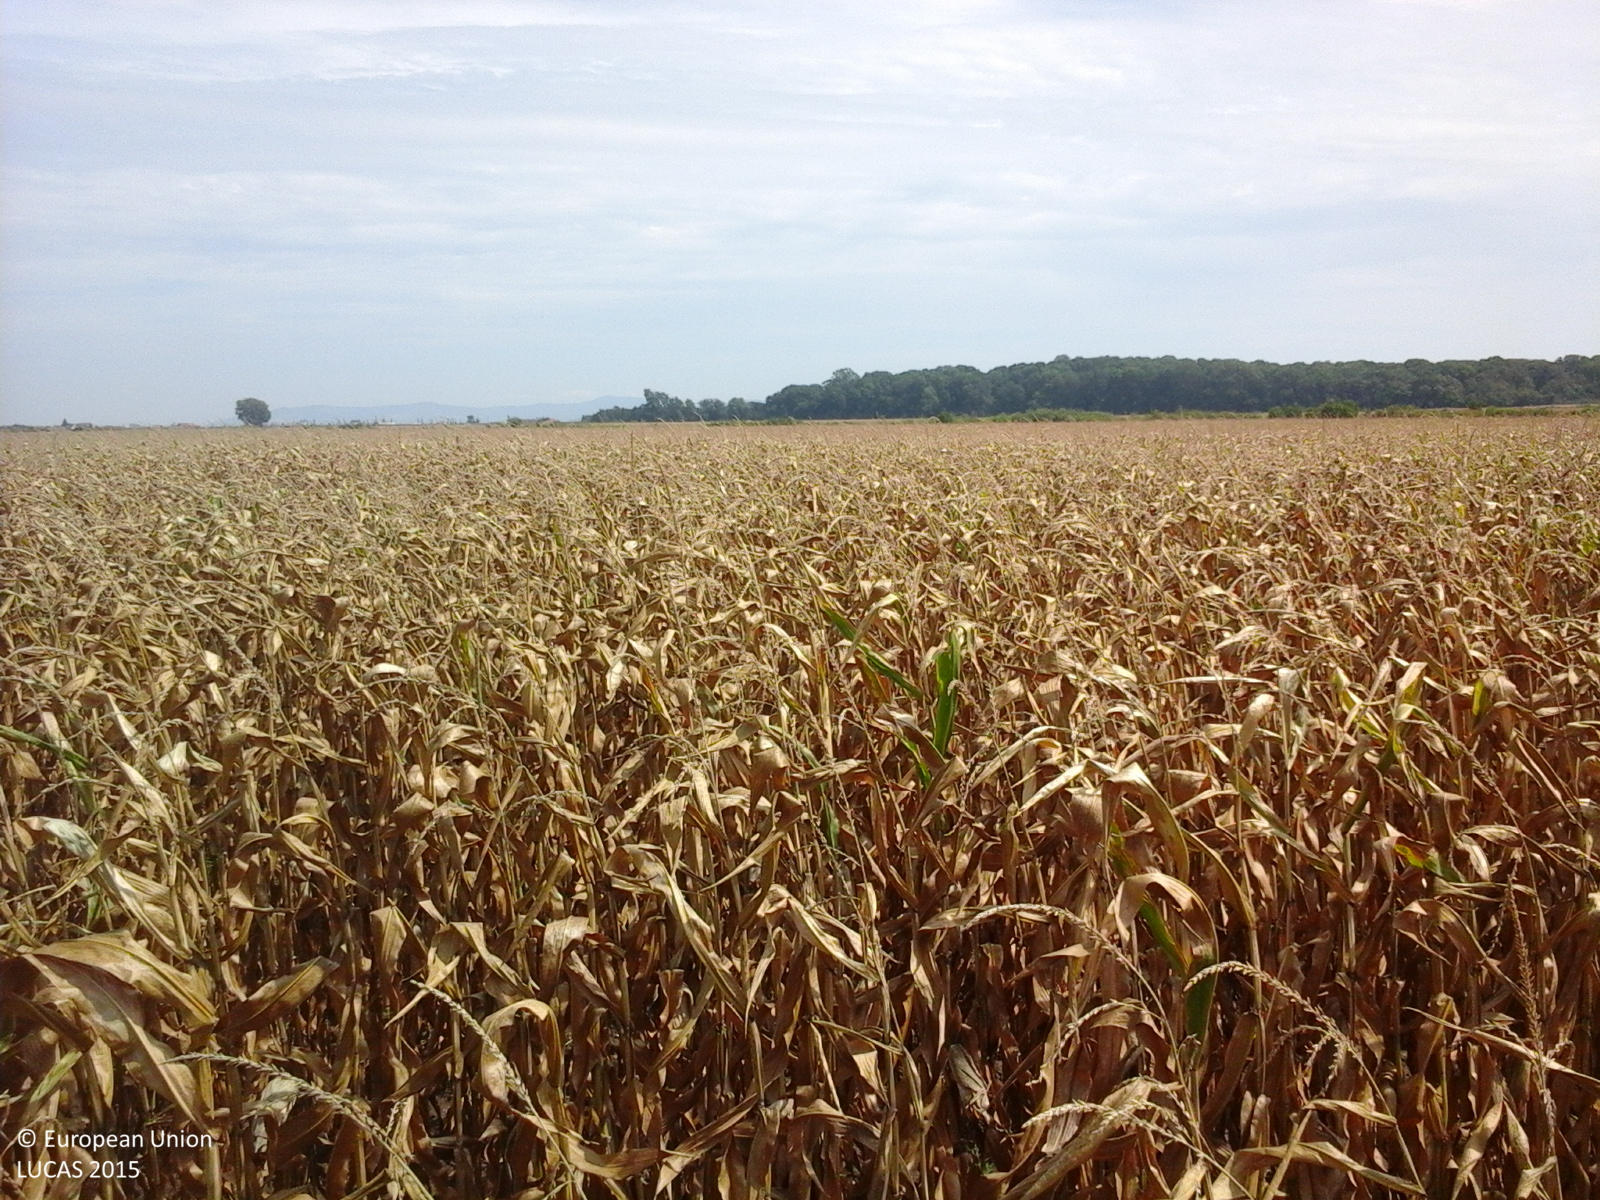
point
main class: Cropland
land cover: Maize
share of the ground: > 75 %
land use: Agriculture (excluding fallow land and kitchen gardens)
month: August
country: RO
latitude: 46.1409
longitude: 21.3876
